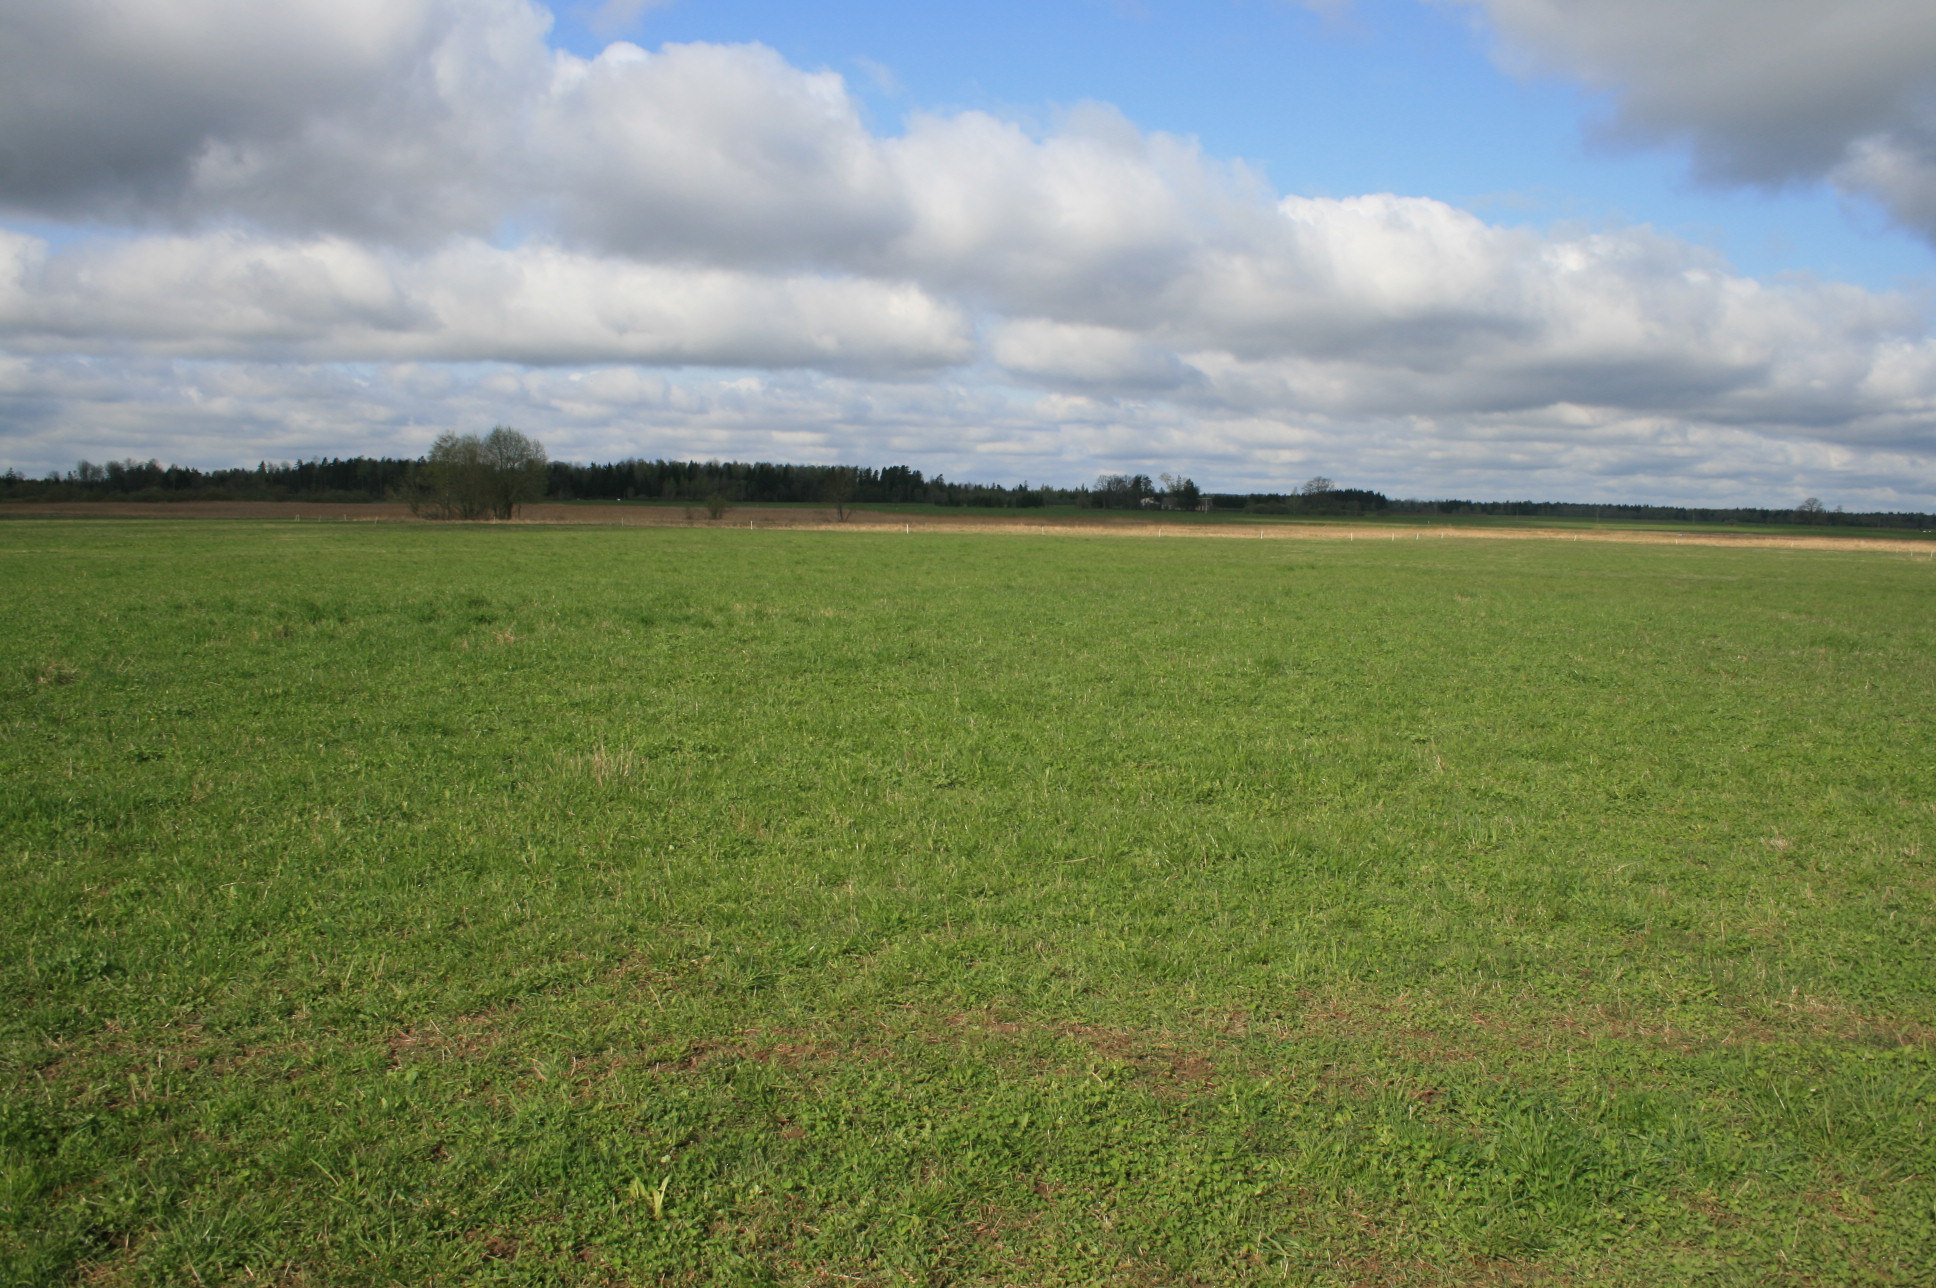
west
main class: Grassland
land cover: Grassland without tree/shrub cover
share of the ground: > 75 %
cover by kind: herbaceous plants 100 %
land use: Agriculture (excluding fallow land and kitchen gardens)
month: May
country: LT
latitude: 56.4025
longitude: 22.0247
